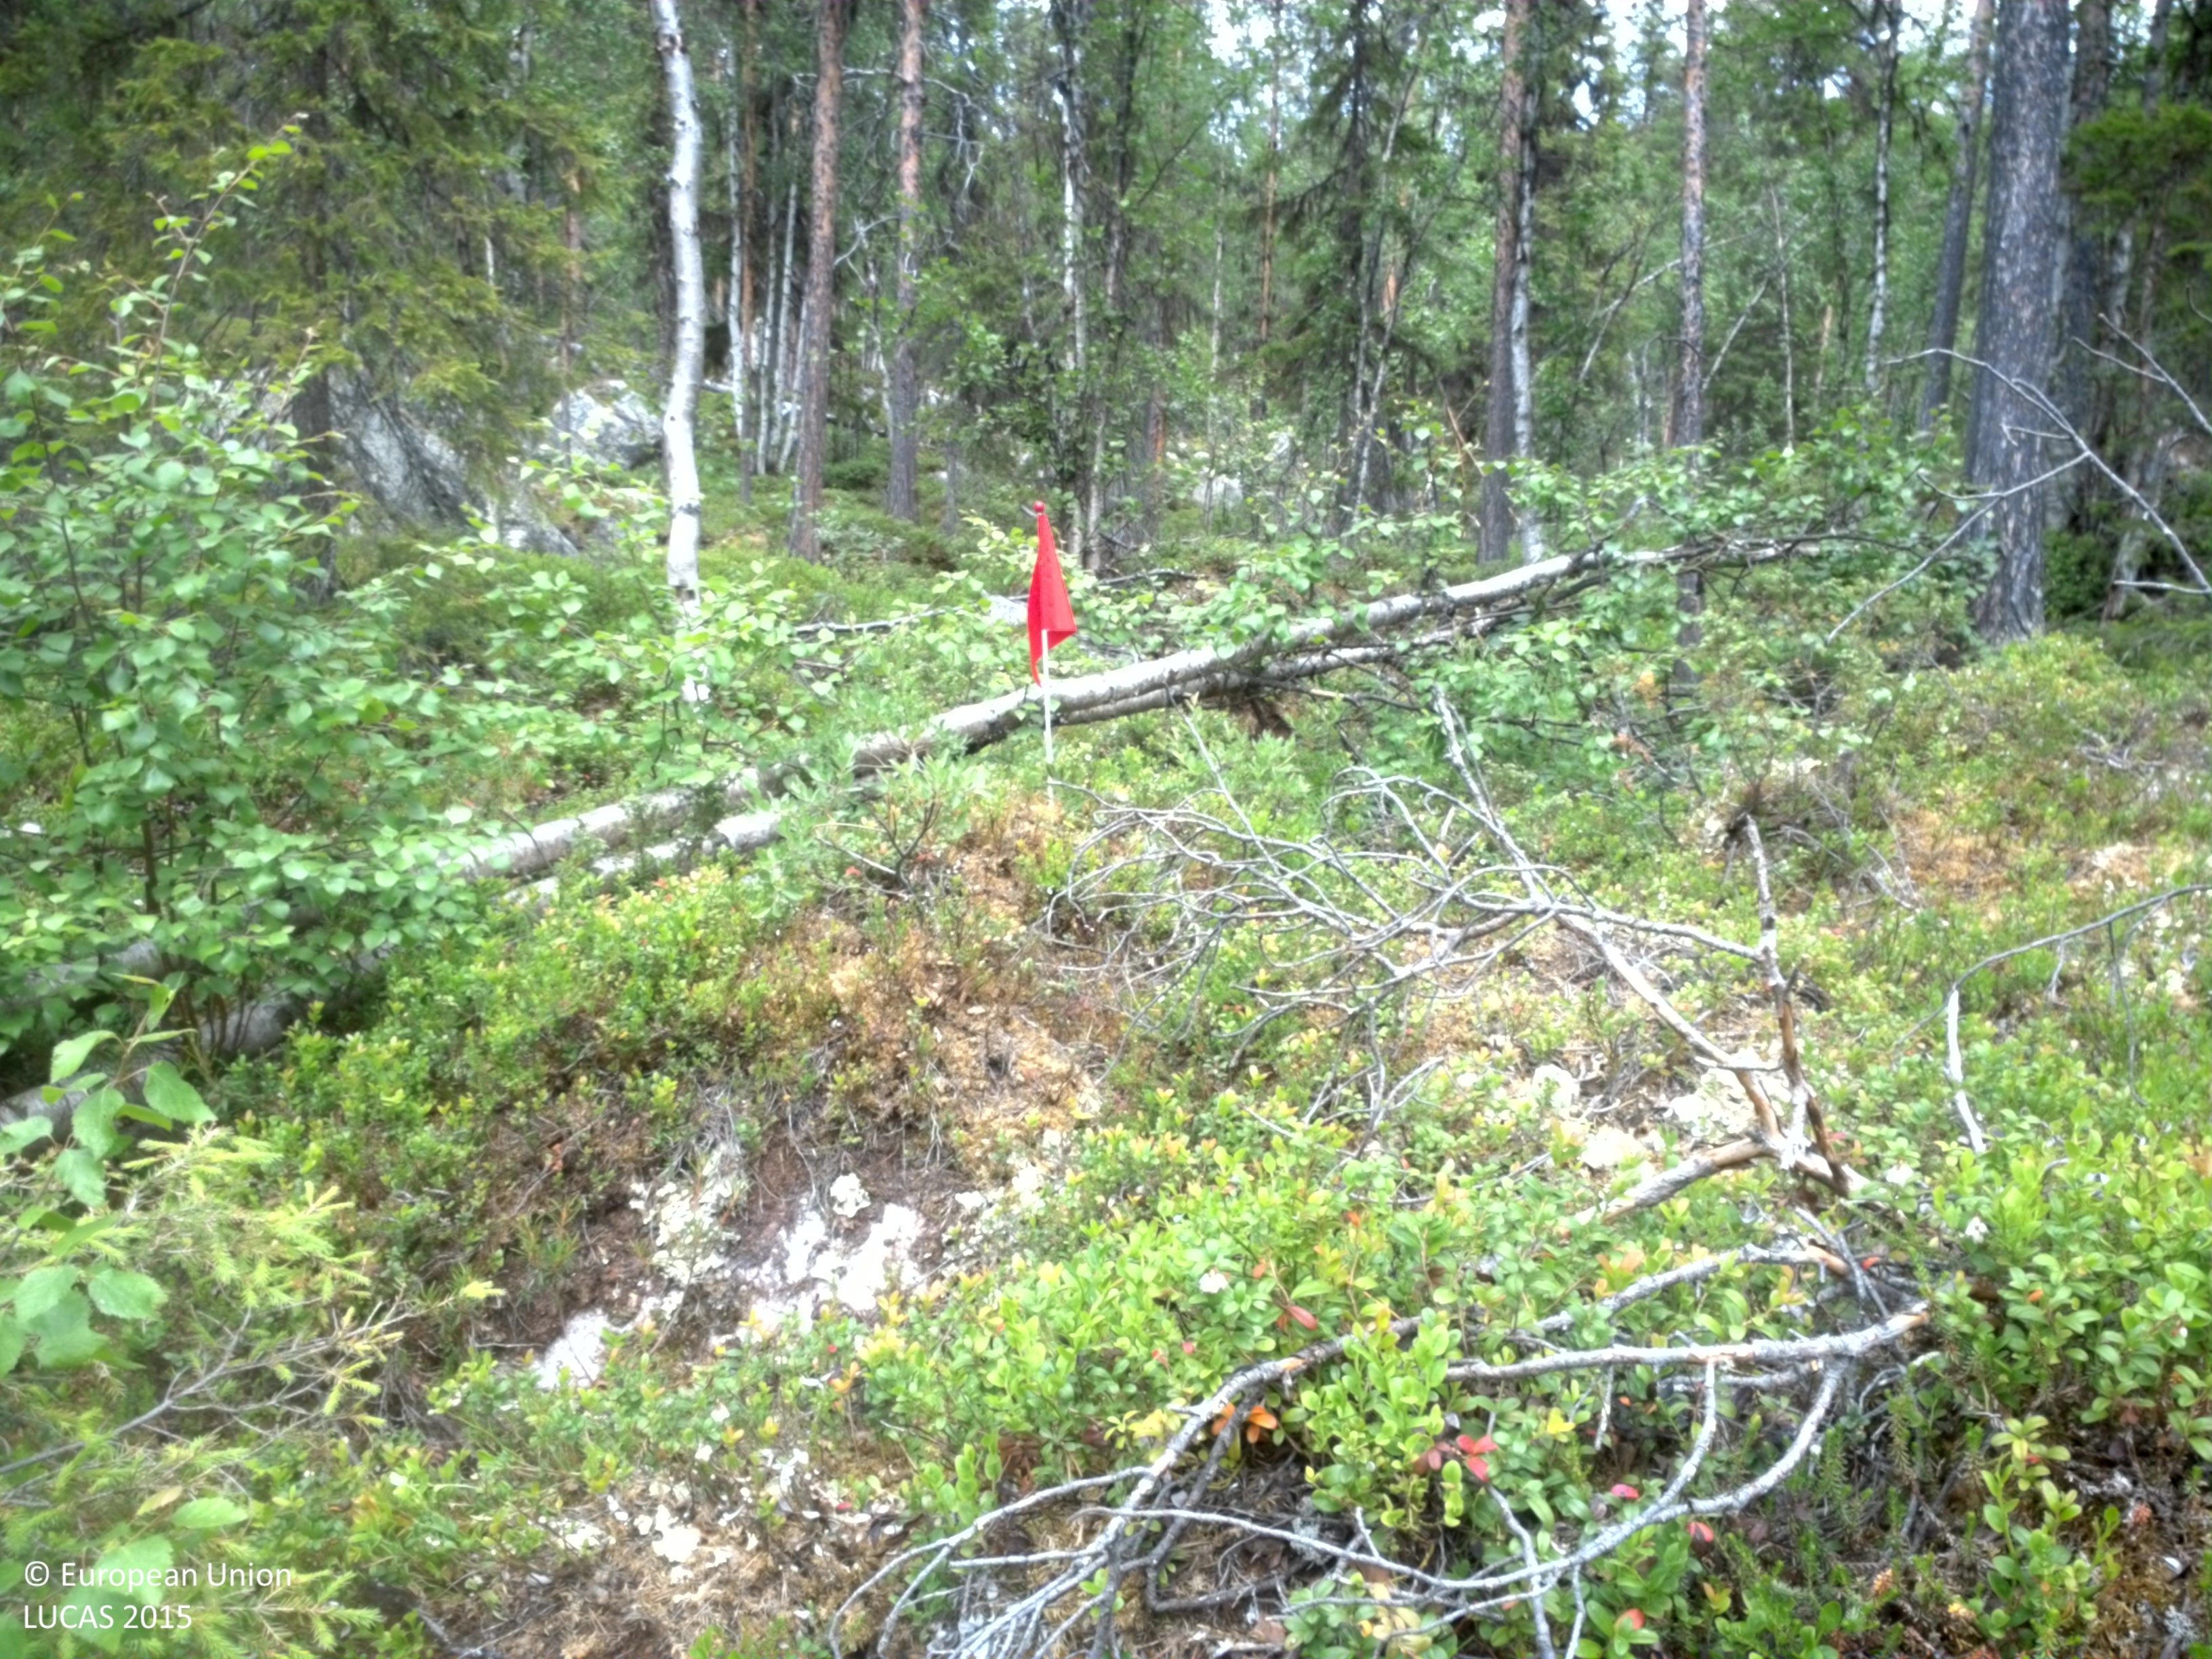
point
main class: Woodland
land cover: Pine dominated coniferous woodland
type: boreal forest
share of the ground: 25 - 50 %
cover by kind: shrubs 50 %, coniferous forest trees 35 %, consolidated bare surface 10 %, broadleaved forest trees 5 %
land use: Forestry
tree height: > 5 m
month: July
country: SE
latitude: 66.8929
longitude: 18.2819
